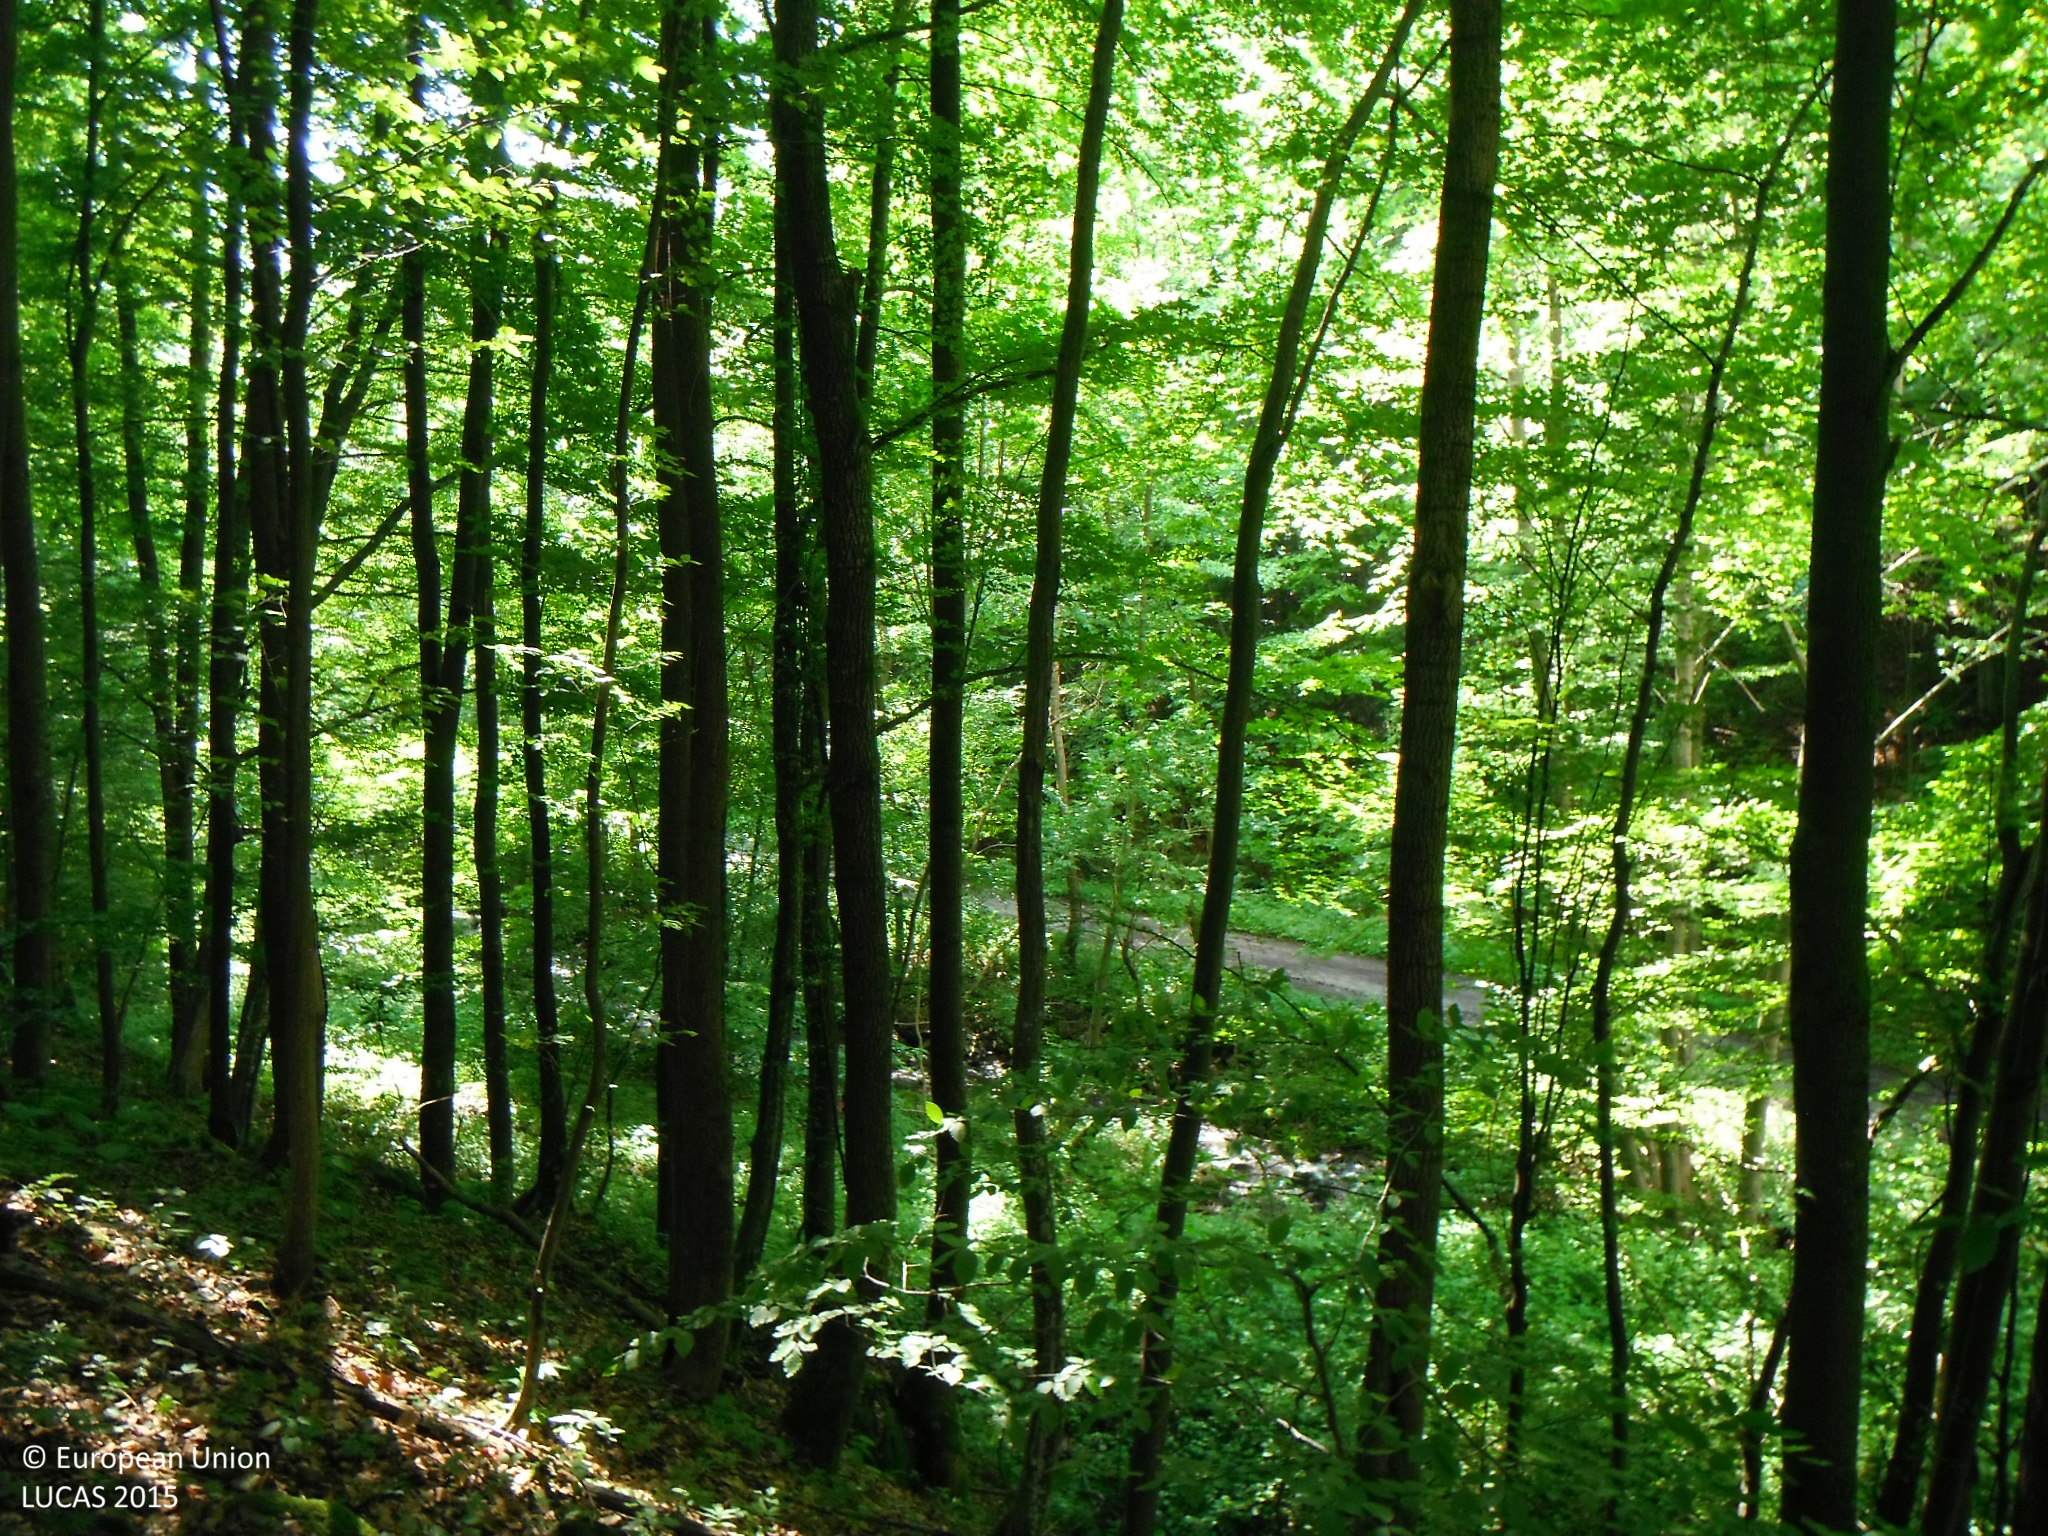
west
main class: Woodland
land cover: Other mixed woodland
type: hemiboreal forest and nemoral coniferous forest and mixed broadleaved-coniferous forest
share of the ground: > 75 %
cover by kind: coniferous forest trees 50 %, broadleaved forest trees 50 %
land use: Forestry
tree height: > 5 m
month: June
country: SK
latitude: 48.6875
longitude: 19.0000
